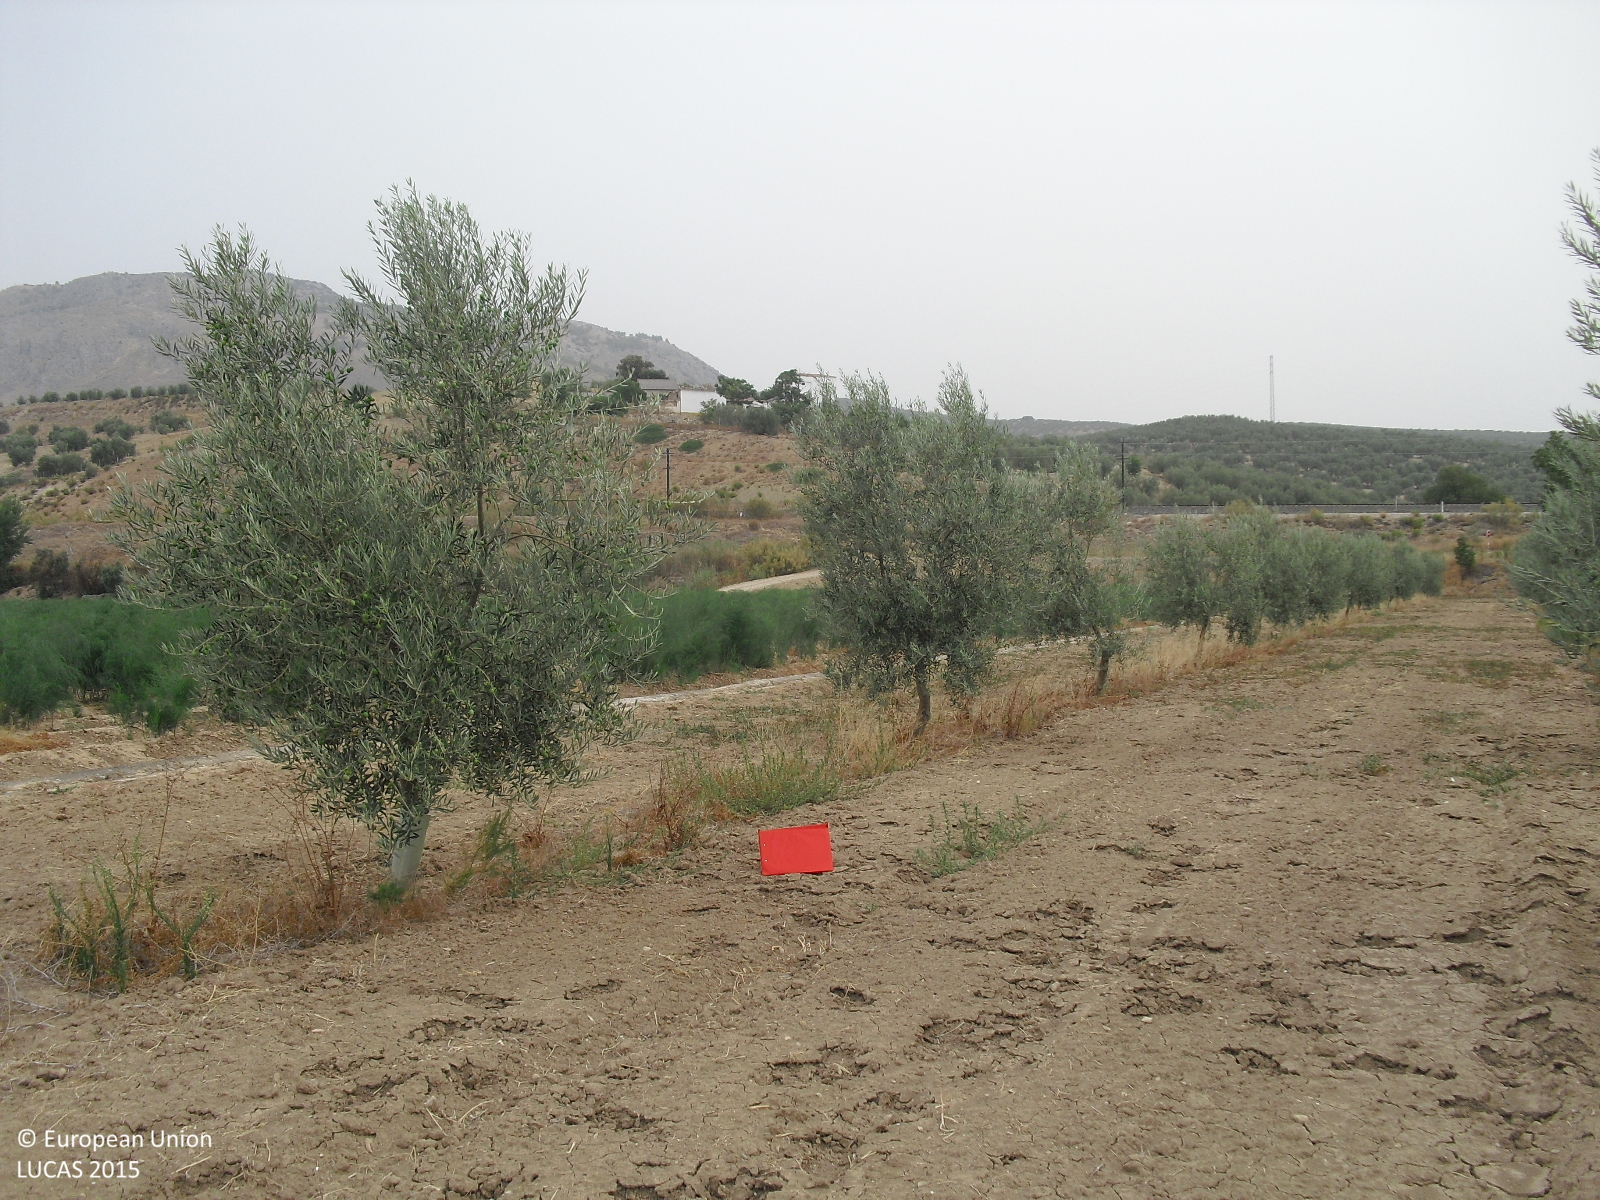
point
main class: Cropland
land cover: Olive groves
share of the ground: < 10 %
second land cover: Spontaneously vegetated surfaces
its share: 10 - 25 %
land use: Agriculture (excluding fallow land and kitchen gardens)
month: August
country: ES
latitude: 37.1683
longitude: -4.1053
